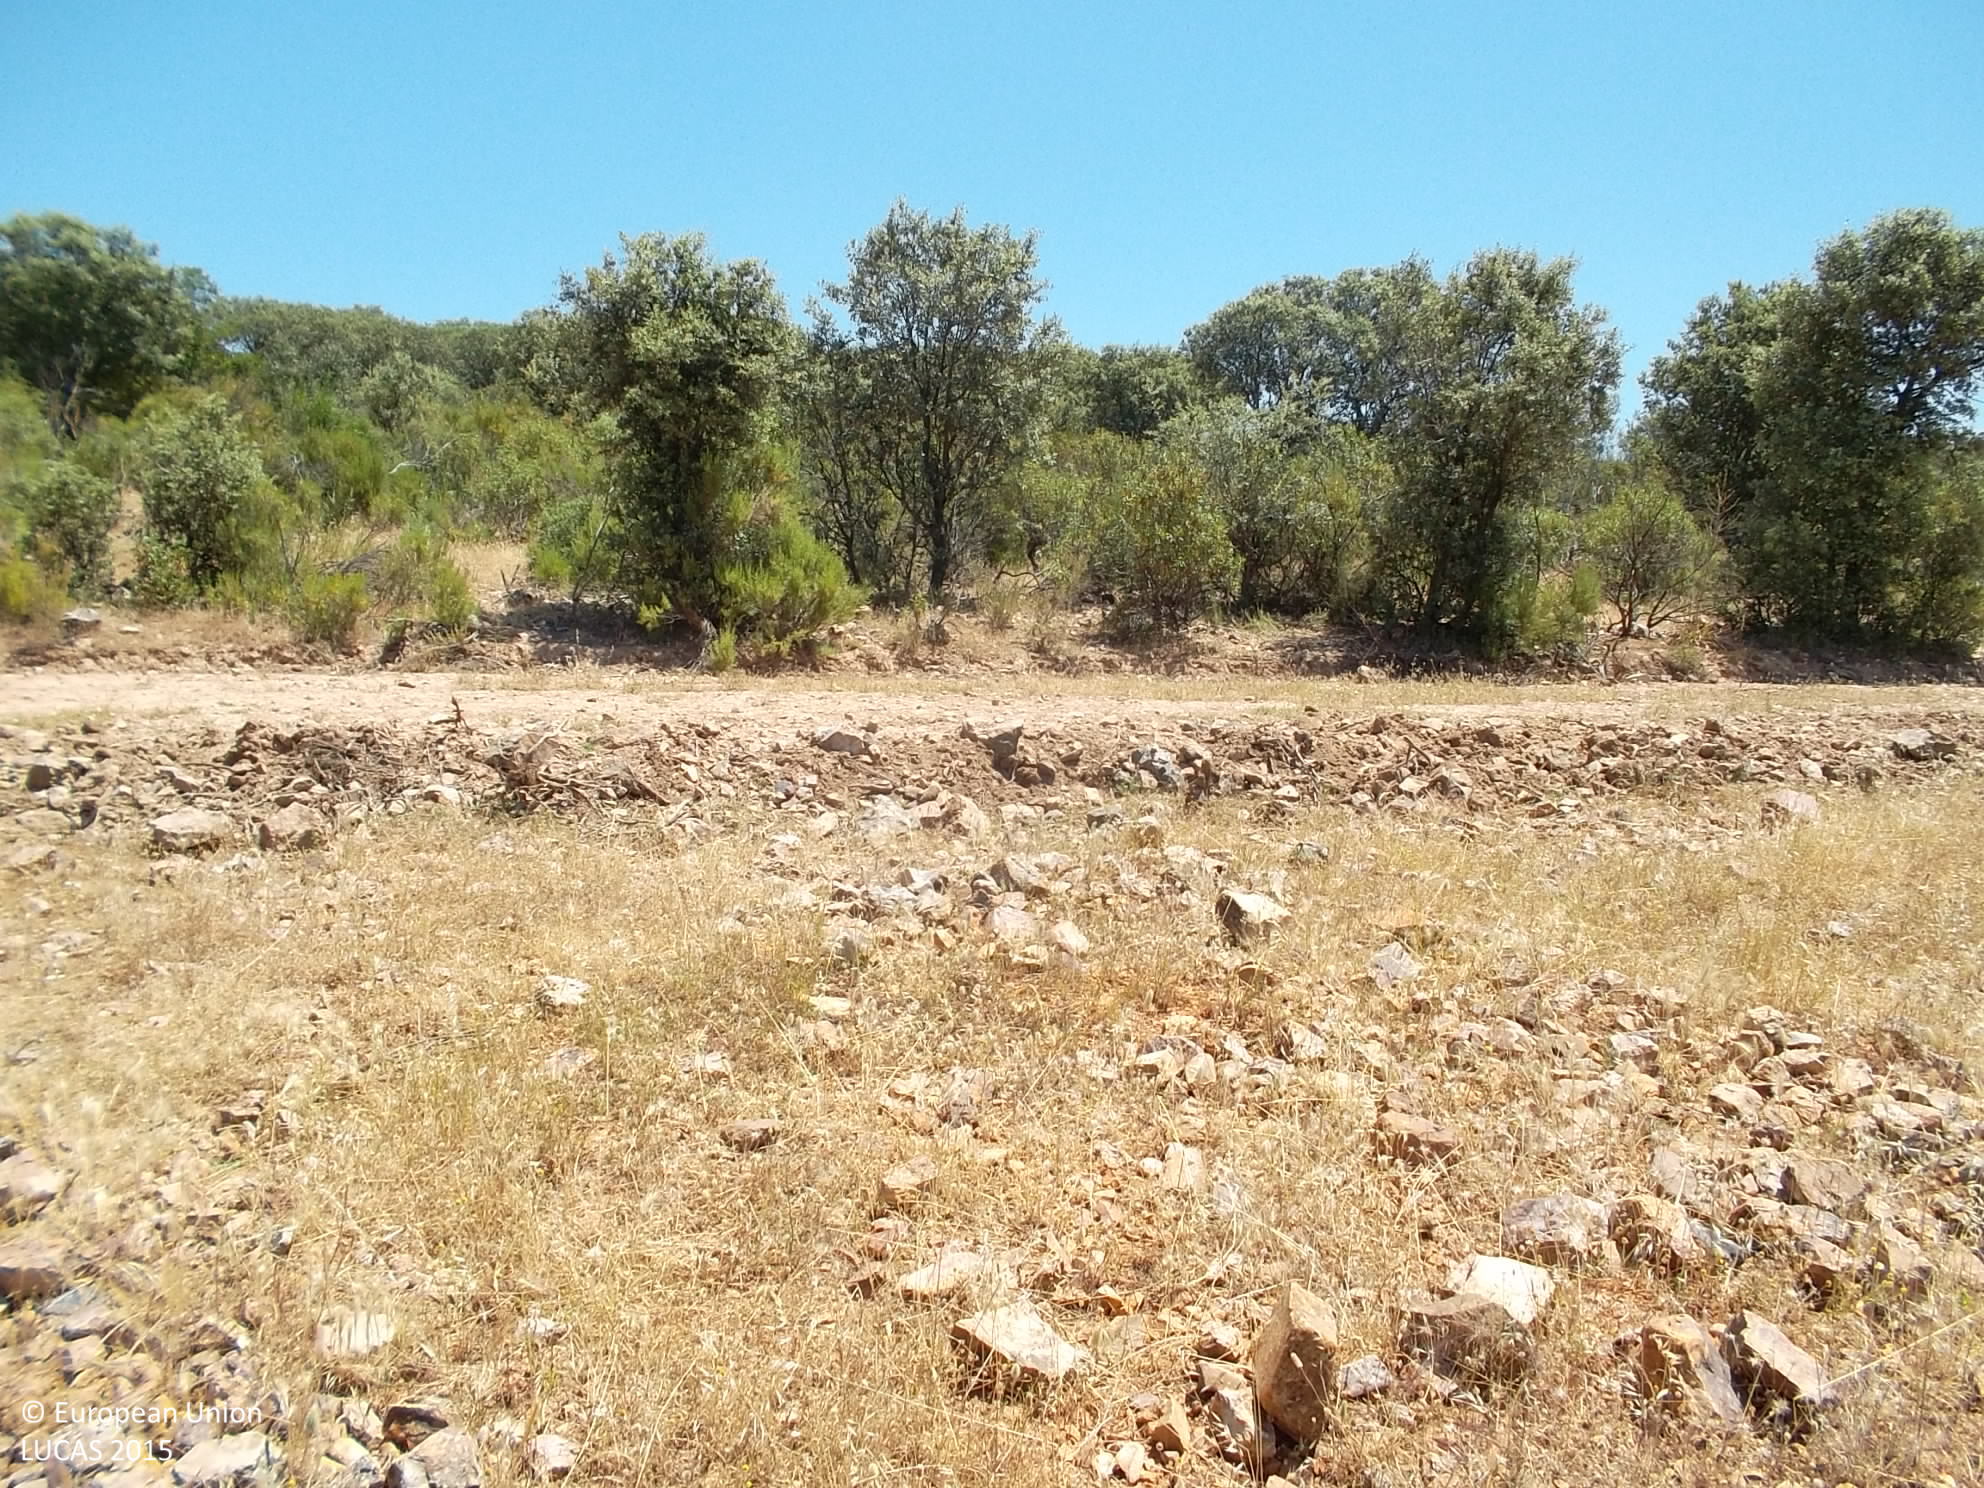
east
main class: Grassland
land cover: Grassland without tree/shrub cover
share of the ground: > 75 %
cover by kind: herbaceous plants 90 %, shrubs 5 %, consolidated bare surface 5 %
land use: Agriculture (excluding fallow land and kitchen gardens)
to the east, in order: Grassland without tree/shrub cover; Broadleaved woodland; Shrubland with sparse tree cover; Rock outcrops; Broadleaved woodland; Shrubland with sparse tree cover
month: June
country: ES
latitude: 39.1184
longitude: -4.0770
